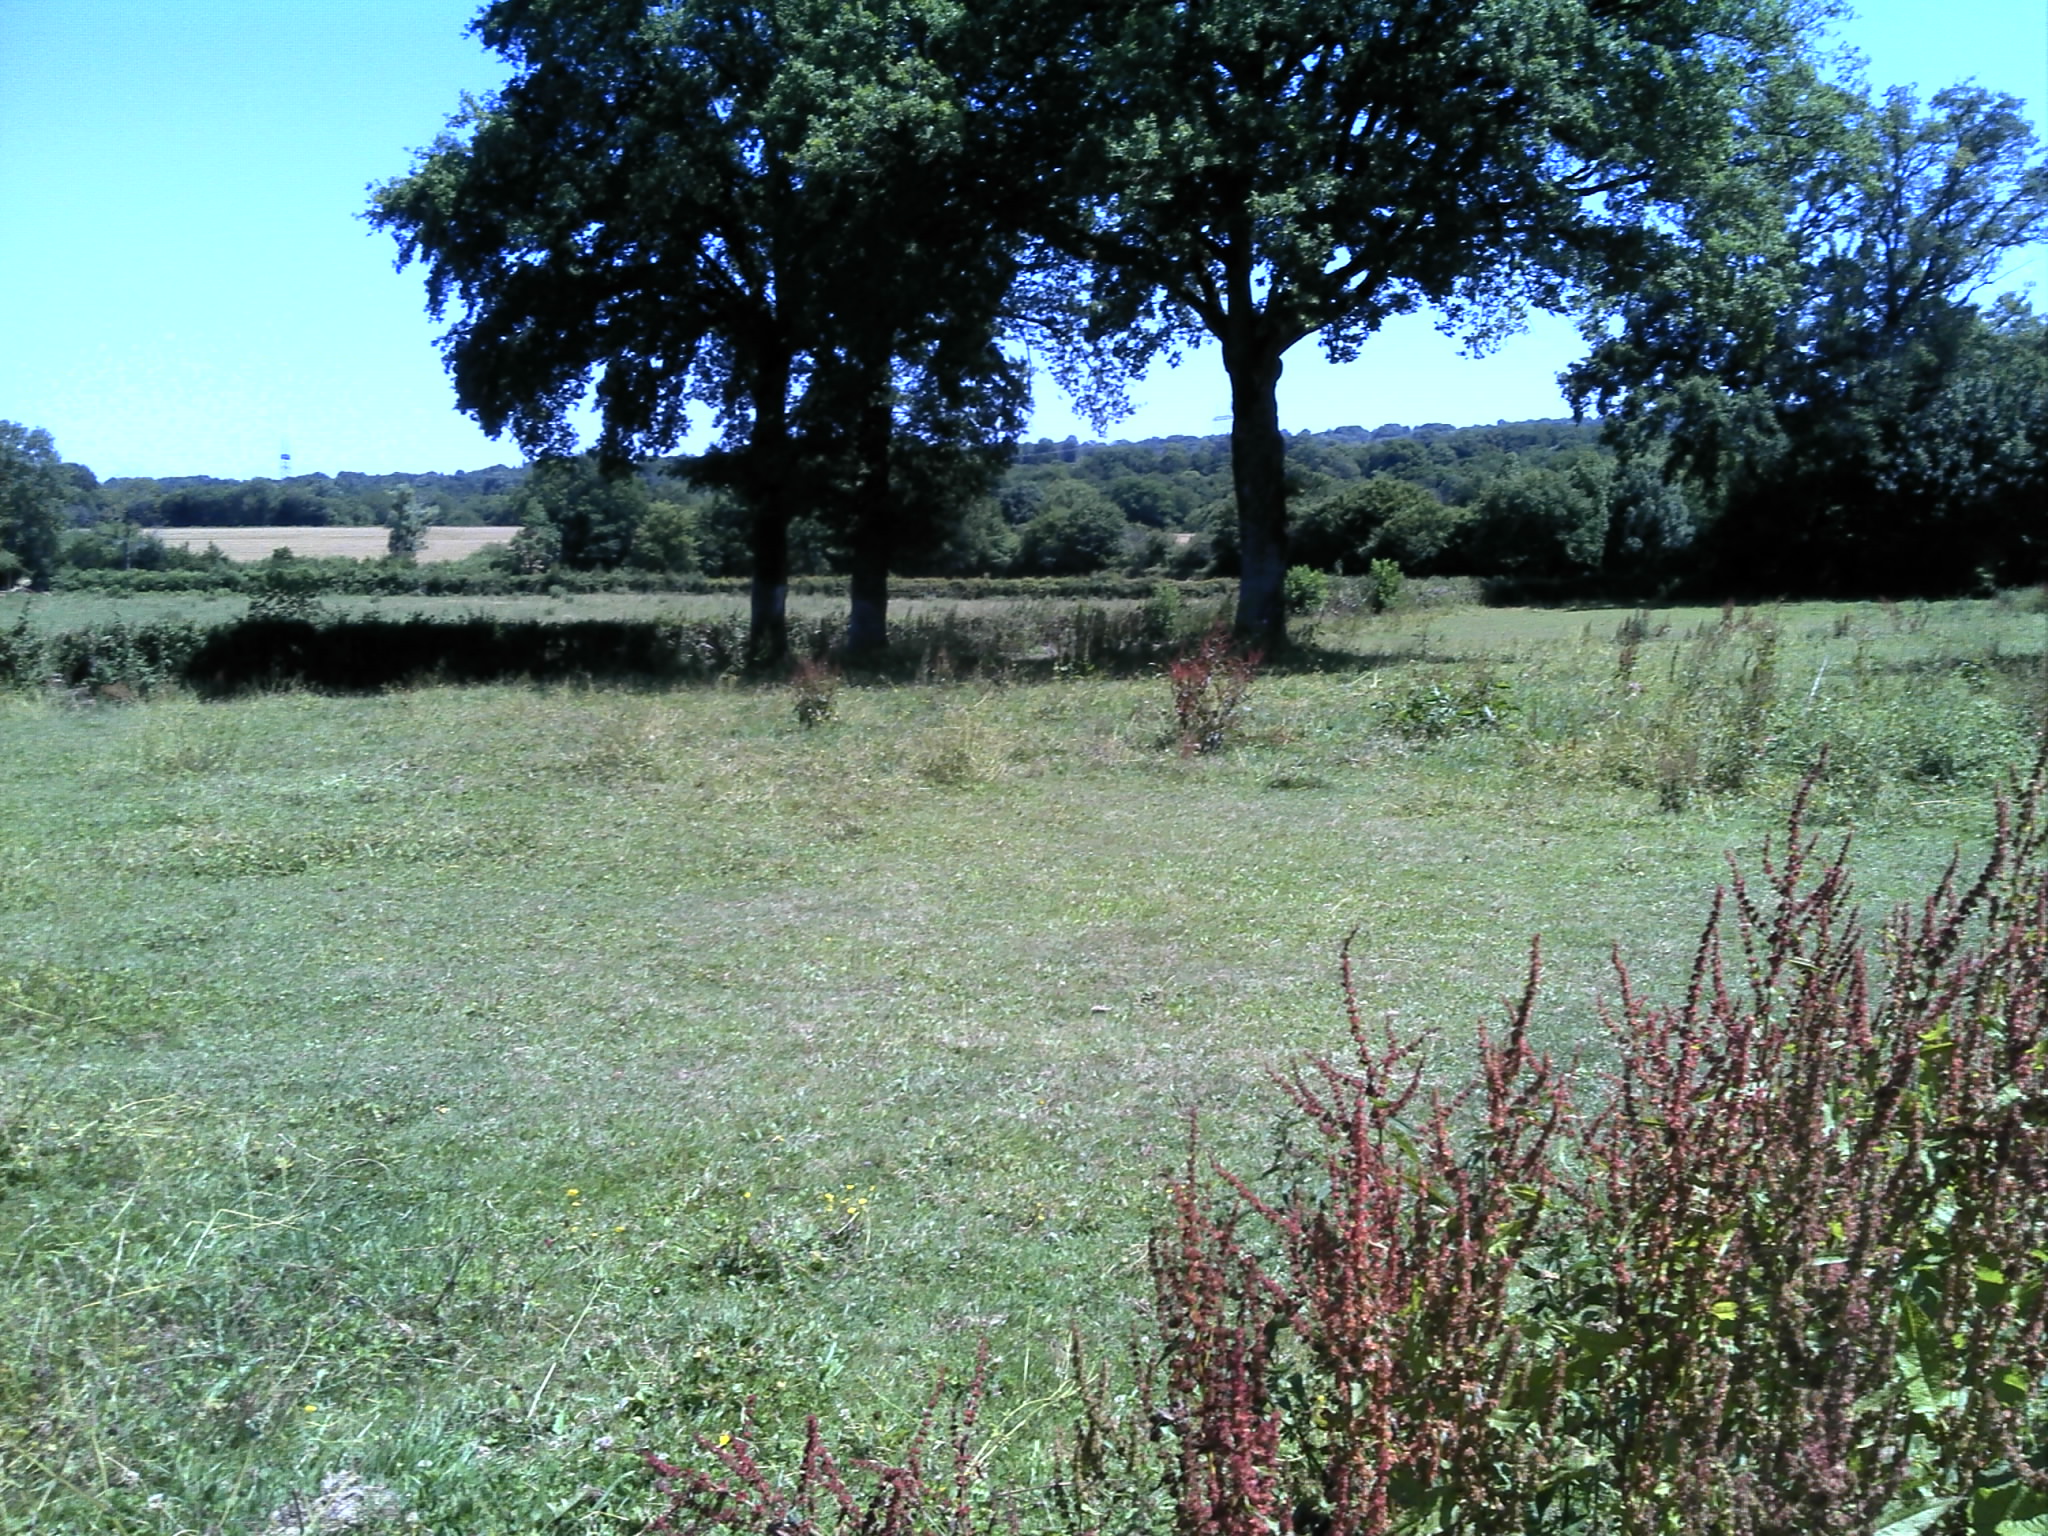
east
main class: Grassland
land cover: Grassland with sparse tree/shrub cover
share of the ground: > 75 %
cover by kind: herbaceous plants 90 %, broadleaved forest trees 5 %, shrubs 5 %
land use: Agriculture (excluding fallow land and kitchen gardens)
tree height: > 5 m
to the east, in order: Grassland with sparse tree/shrub cover; Managed hedges; Fences; Grassland without tree/shrub cover; Fences; Managed hedges; Grassland without tree/shrub cover
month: June
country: FR
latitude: 46.4995
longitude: 2.1885
